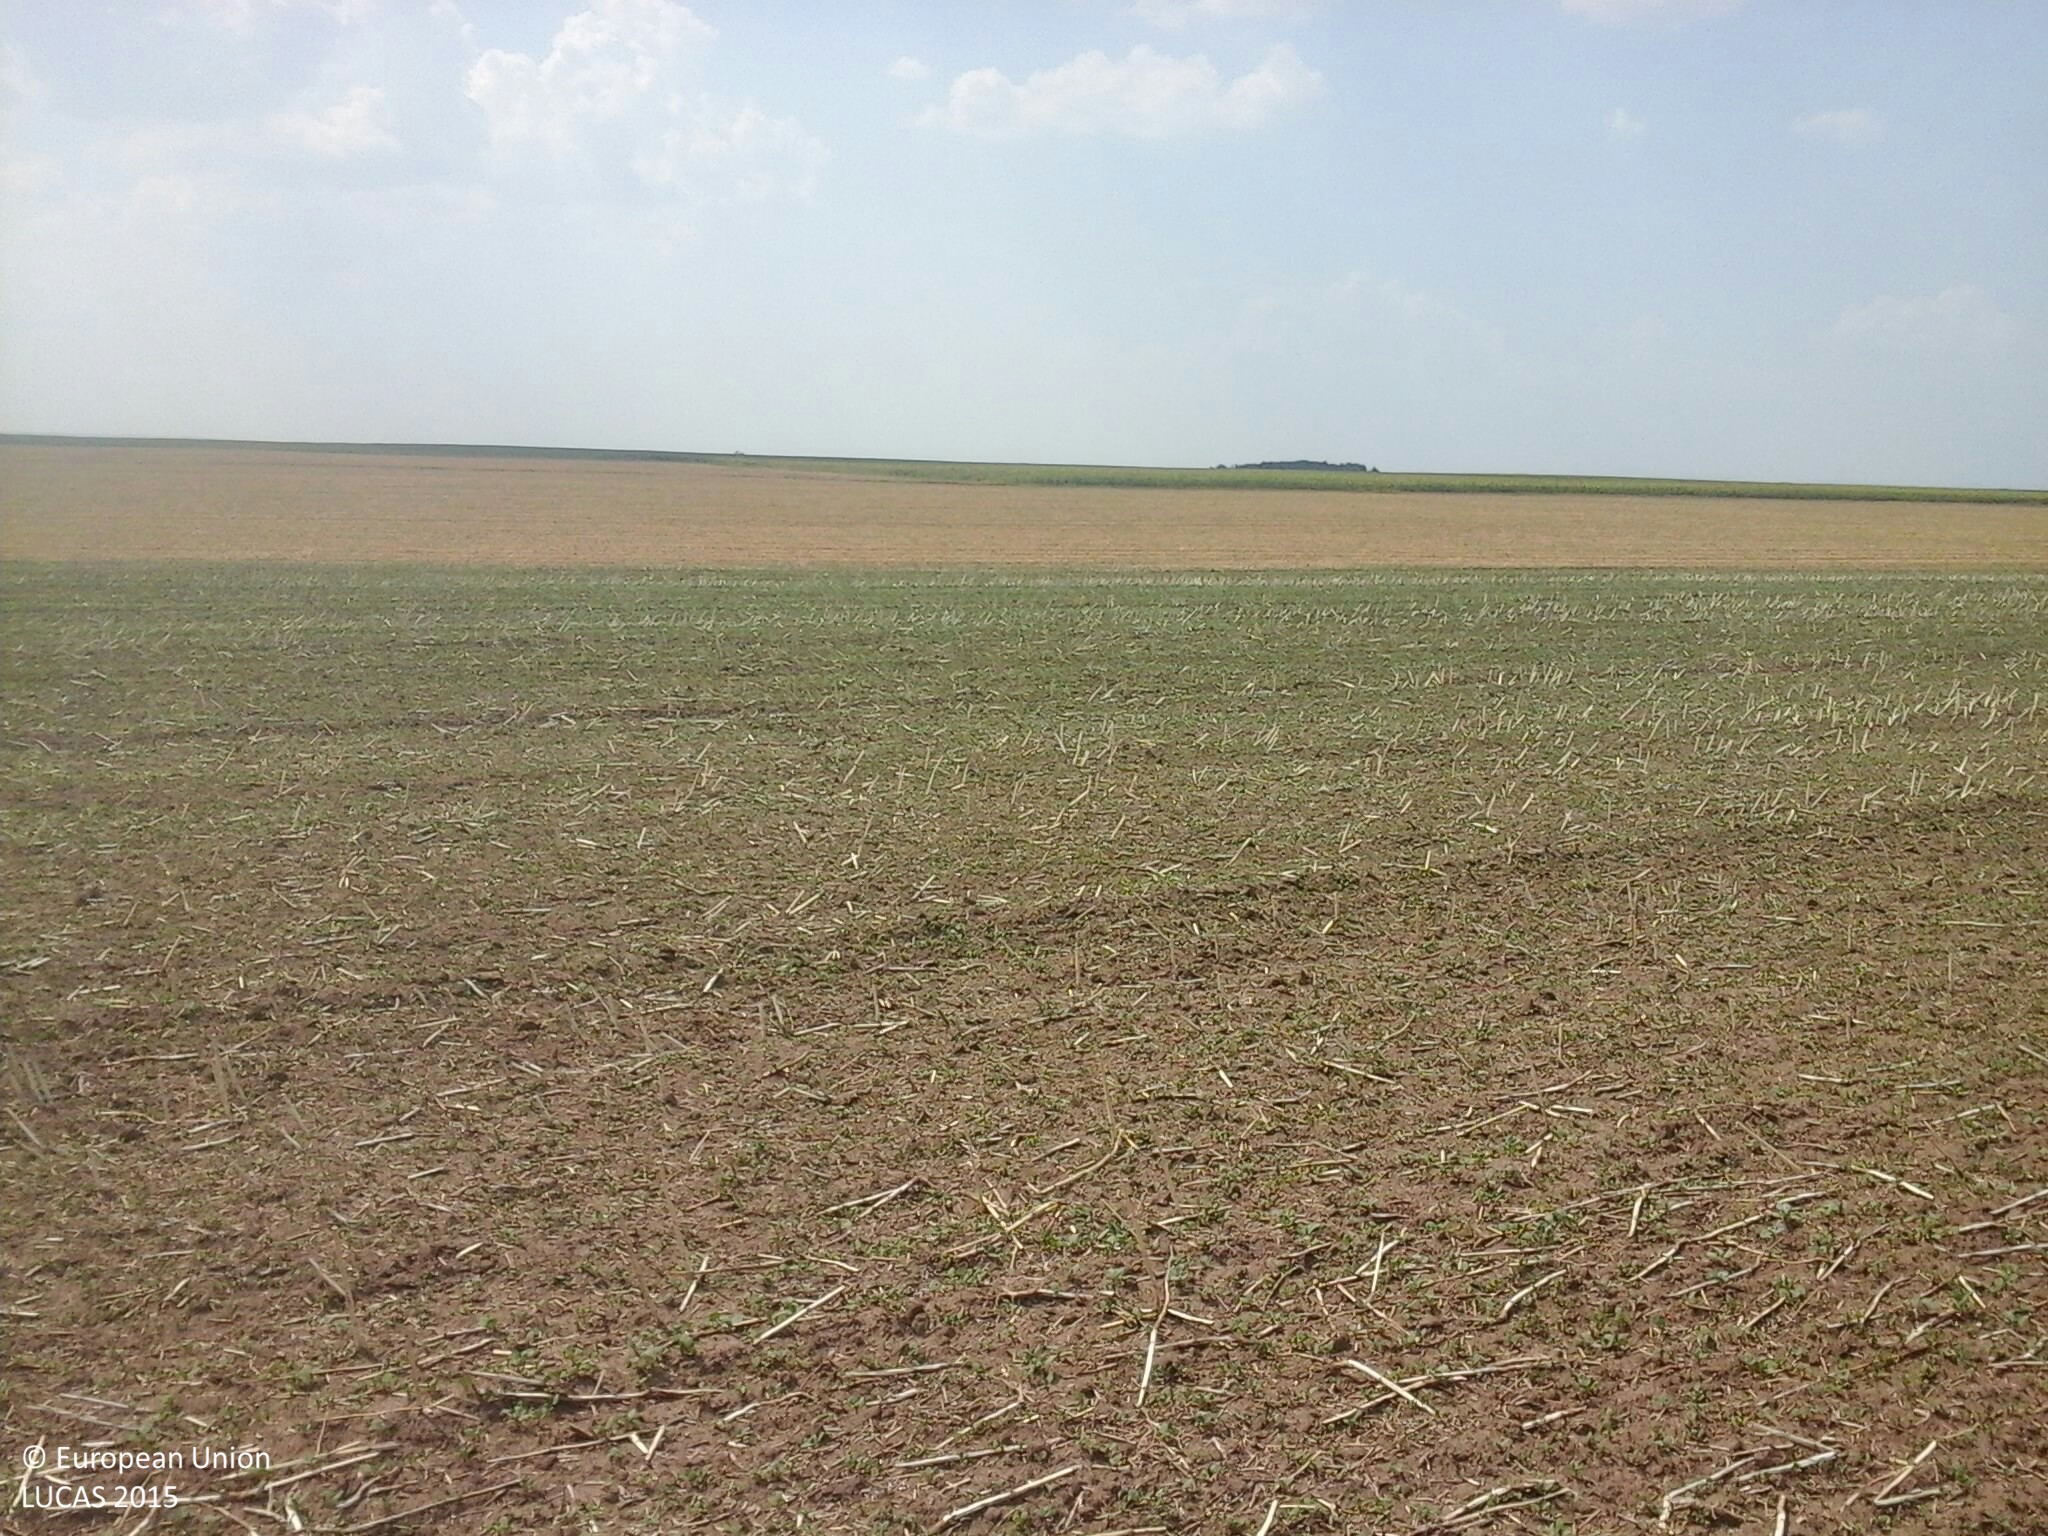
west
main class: Cropland
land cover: Rape and turnip rape
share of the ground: < 10 %
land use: Agriculture (excluding fallow land and kitchen gardens)
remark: Harvested field
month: August
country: HU
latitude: 46.8837
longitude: 18.2381
